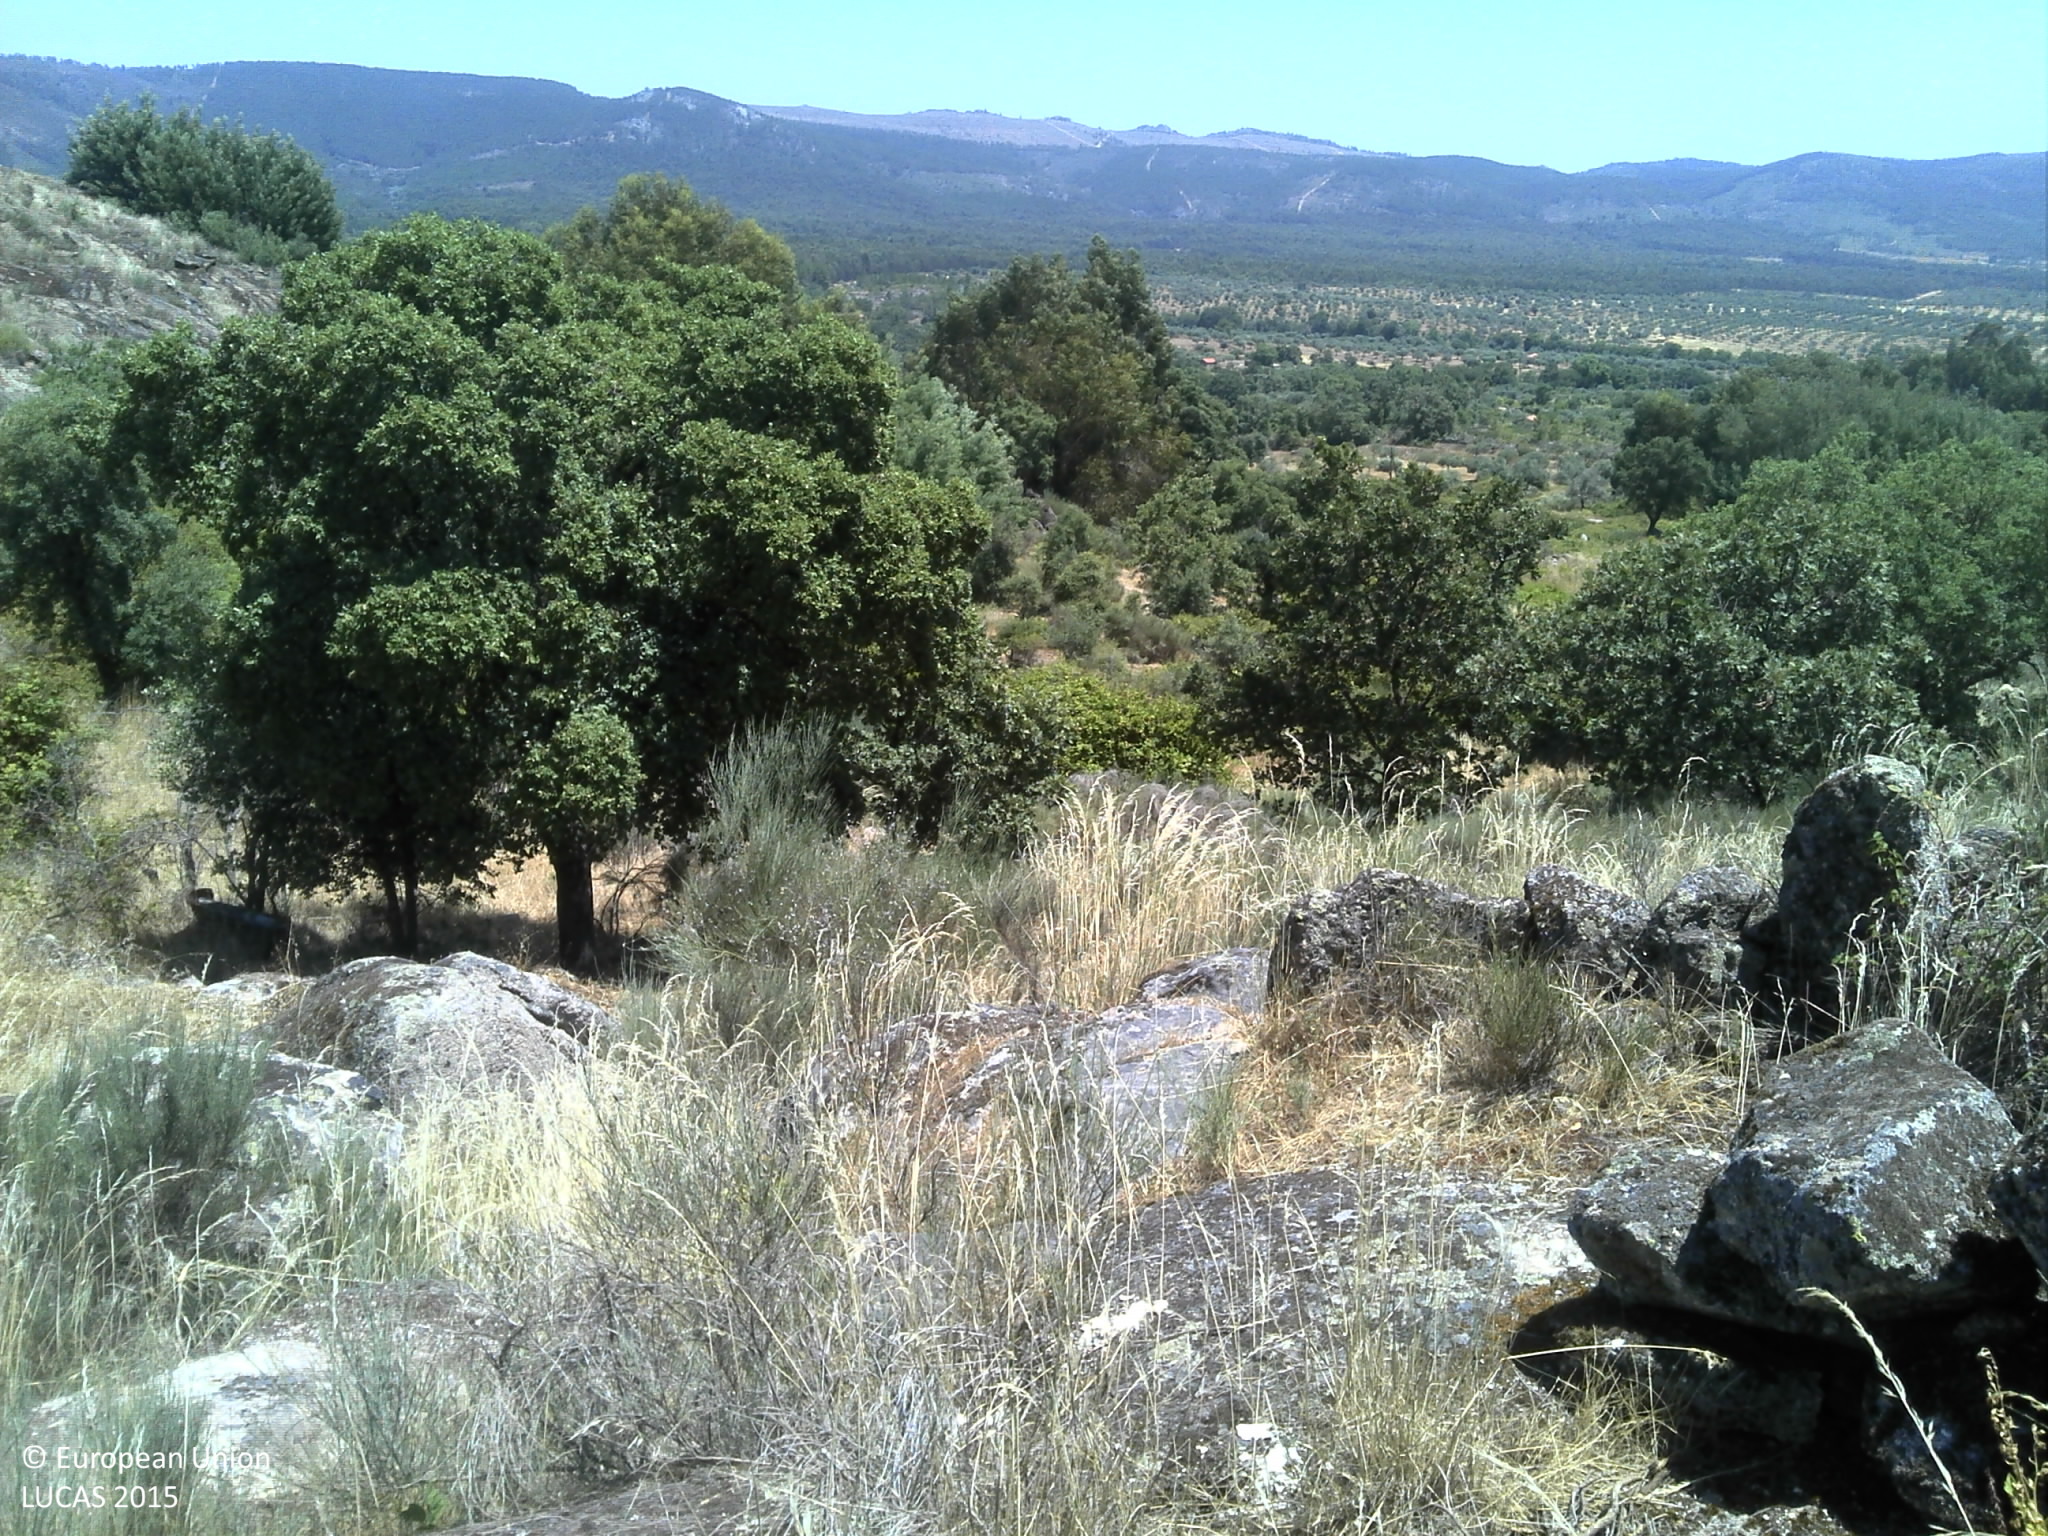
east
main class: Shrubland
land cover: Shrubland with sparse tree cover
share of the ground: 50 - 75 %
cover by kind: shrubs 60 %, herbaceous plants 25 %, broadleaved forest trees 5 %, unconsolidated bare surface 5 %
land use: Forestry
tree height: > 5 m
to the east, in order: Shrubland with sparse tree cover; Rocks and stones; Shrubland with sparse tree cover; Rocks and stones; Shrubland with sparse tree cover; Rocks and stones; Broadleaved woodland; Dry stone walls; Shrubland without tree cover; Dry stone walls; Grass margins; Paved roads, cycling and walking lanes; Electric lines; Grass margins; Shrubland with sparse tree cover
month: June
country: PT
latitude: 40.0620
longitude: -7.1053
